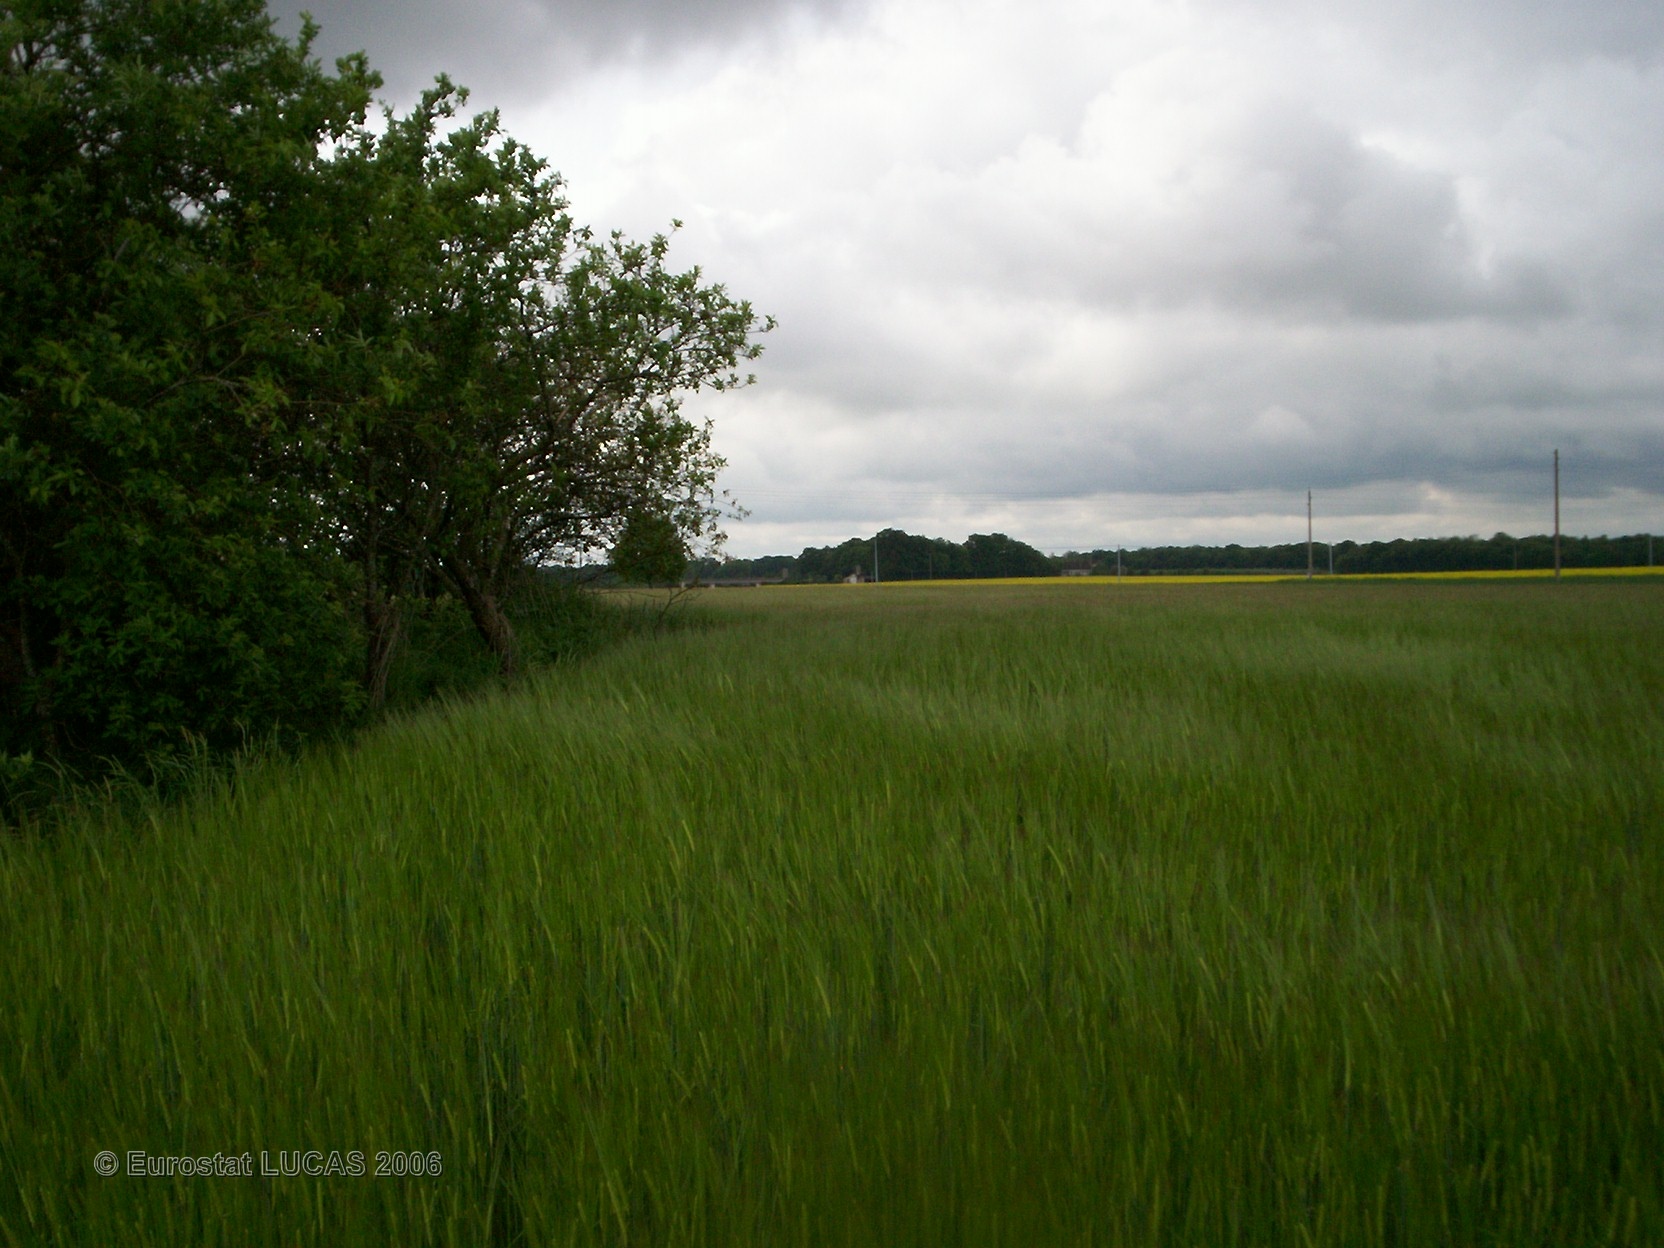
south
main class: Cropland
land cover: Barley
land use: Agriculture (excluding fallow land and kitchen gardens)
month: May
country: FR
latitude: 47.9982
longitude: 2.9566
